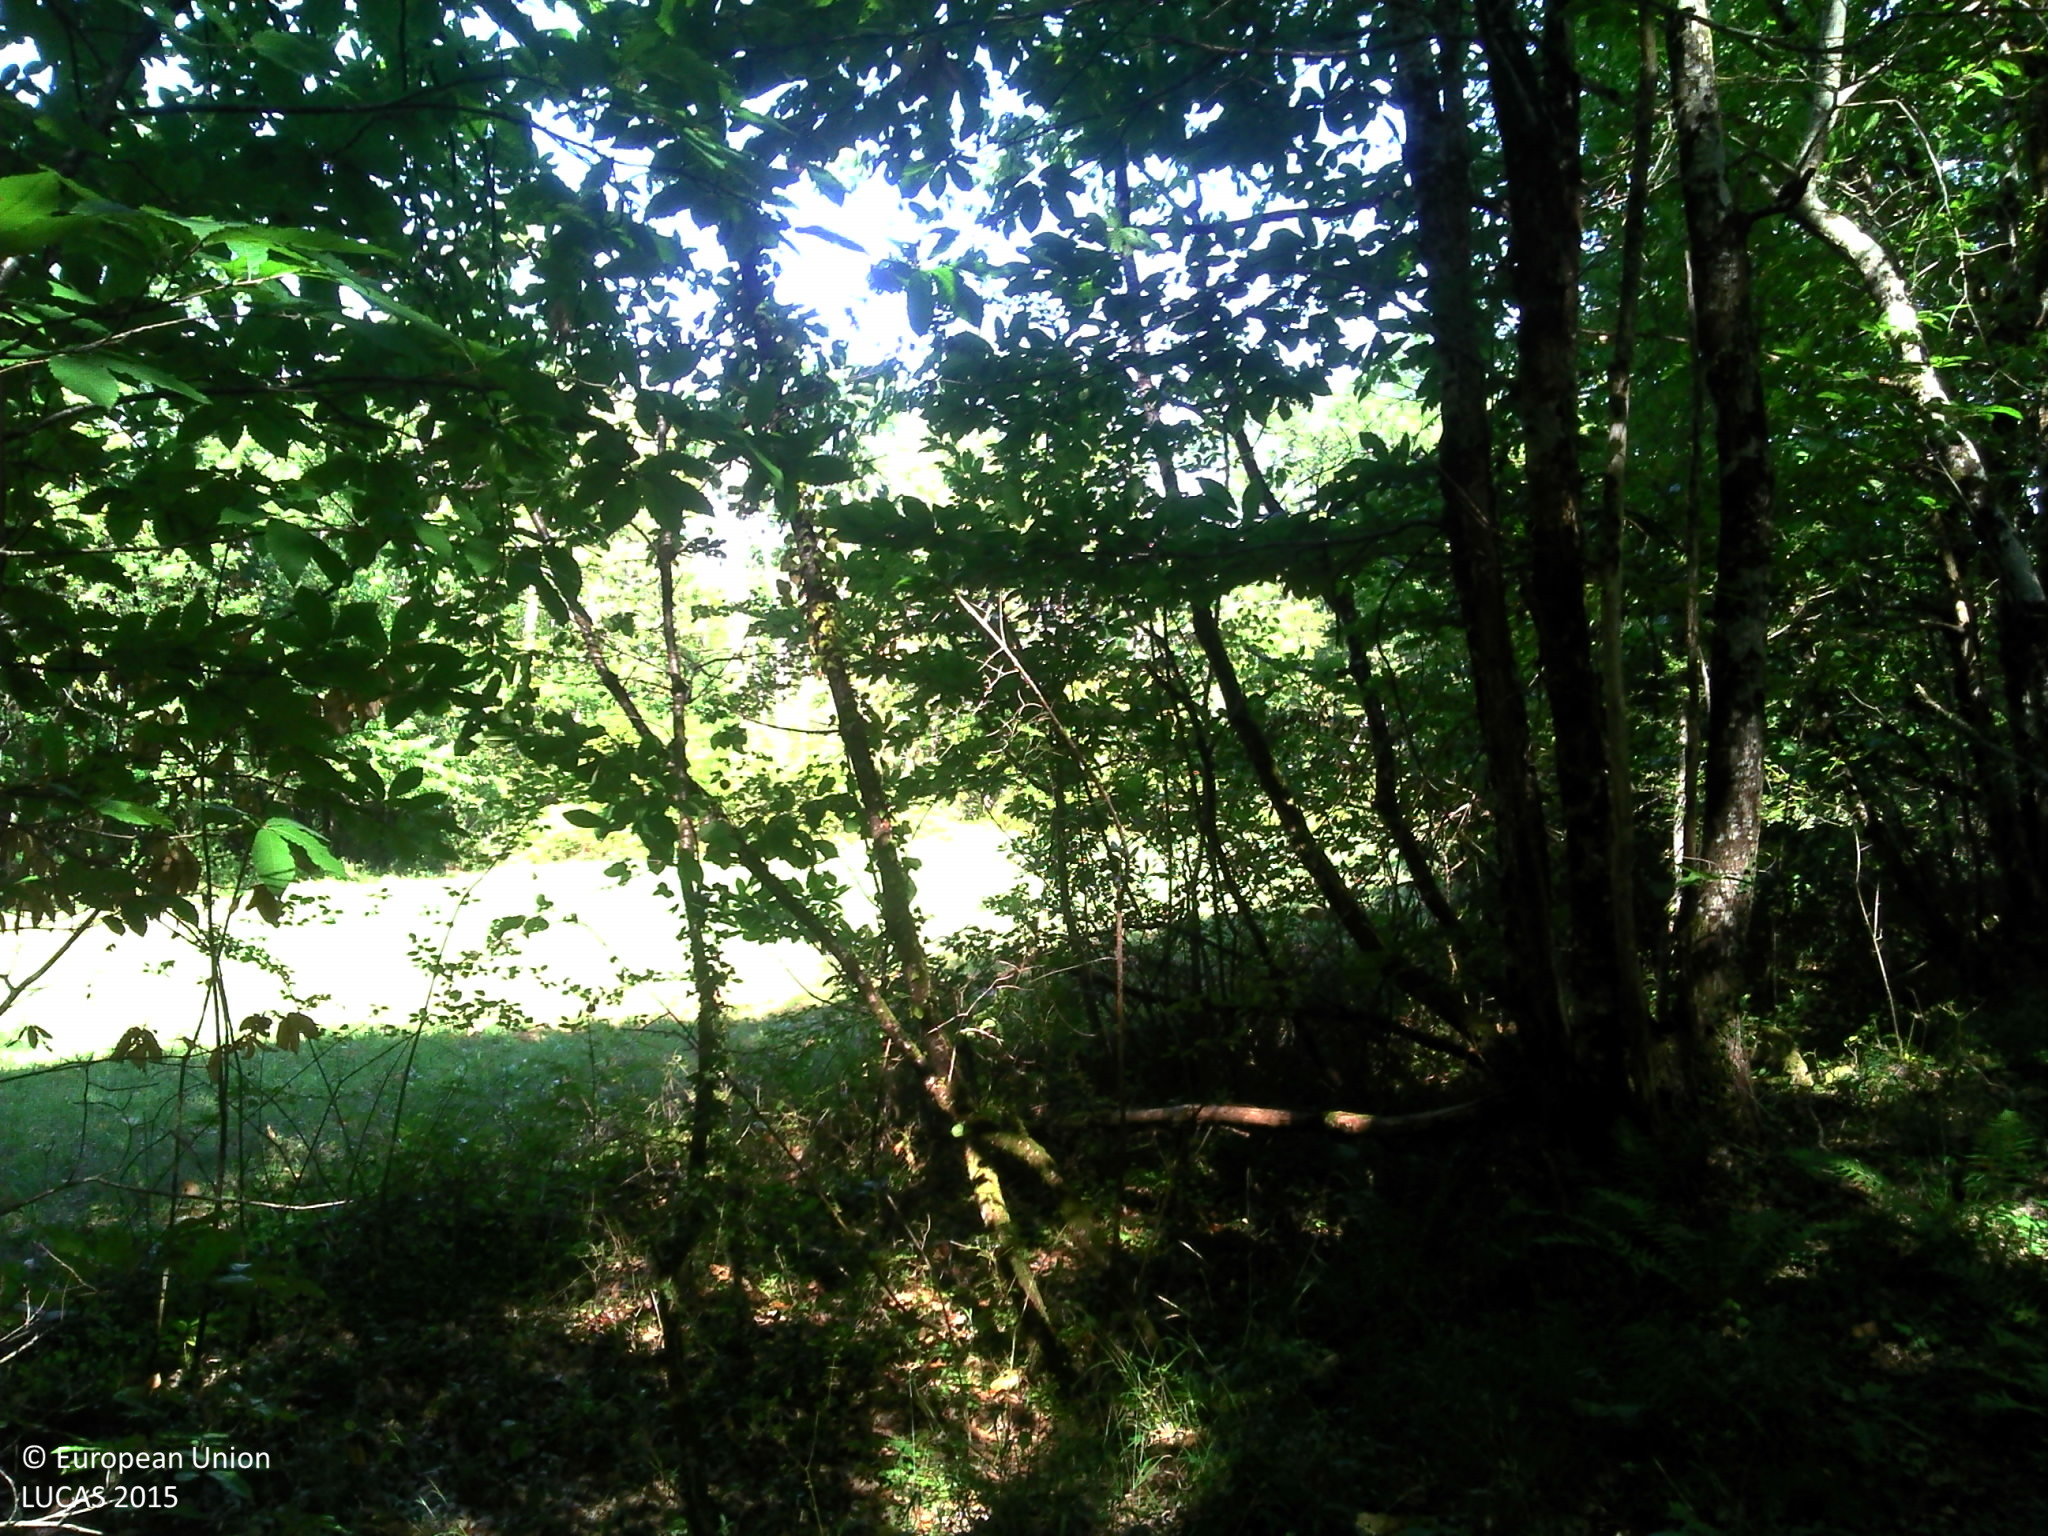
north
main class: Woodland
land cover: Broadleaved woodland
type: thermophilous deciduous forest
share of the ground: > 75 %
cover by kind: broadleaved forest trees 90 %, herbaceous plants 10 %
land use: Forestry
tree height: > 5 m
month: August
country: FR
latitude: 44.5424
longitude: 1.2493
